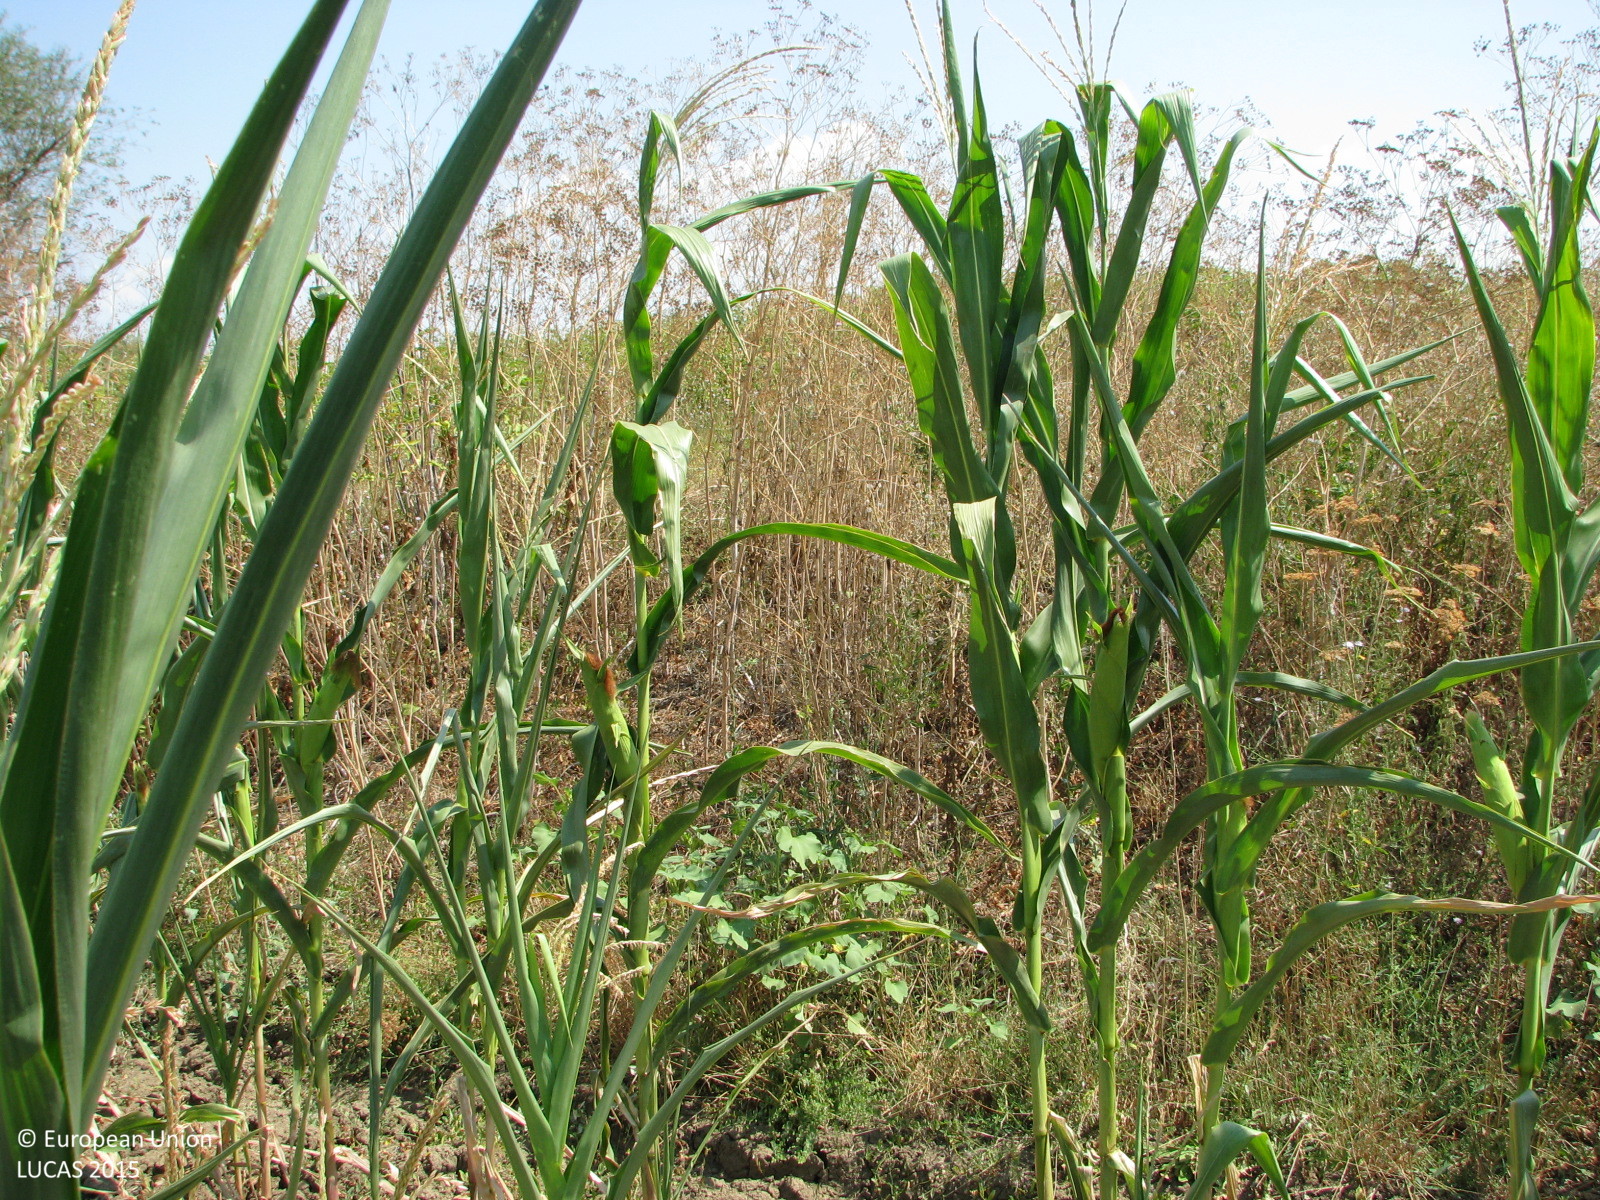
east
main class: Cropland
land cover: Maize
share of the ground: > 75 %
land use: Agriculture (excluding fallow land and kitchen gardens)
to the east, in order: Maize; Spontaneously vegetated surfaces; Tracks; Spontaneously vegetated surfaces
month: August
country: BG
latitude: 42.1545
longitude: 26.6098
